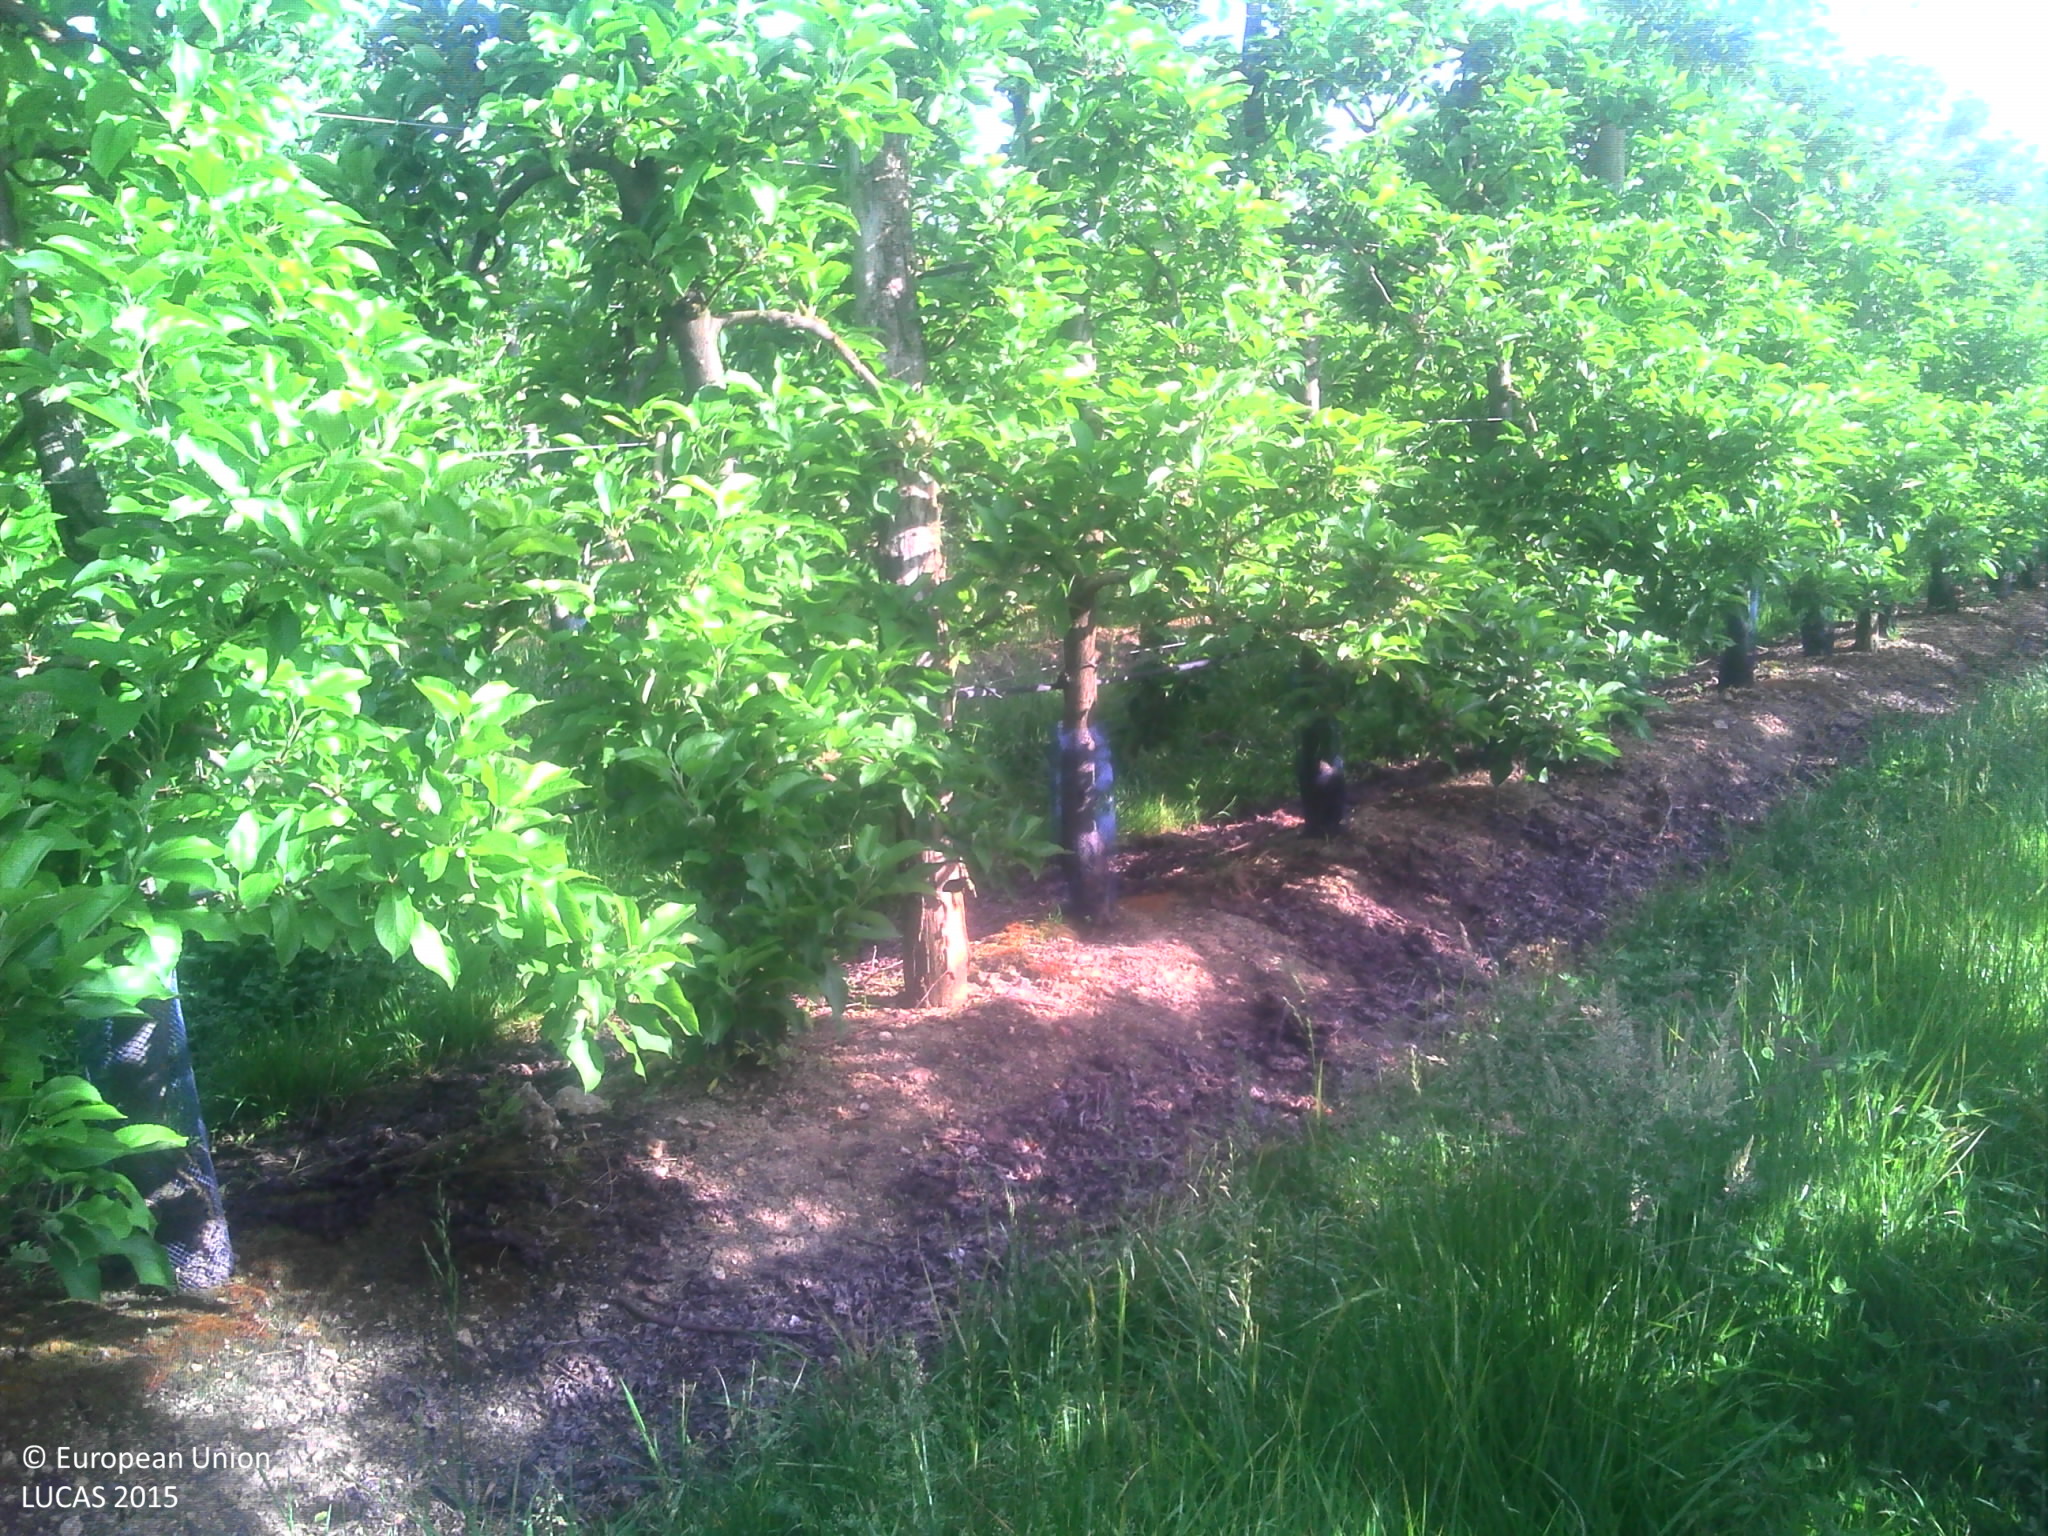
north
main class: Cropland
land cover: Apple fruit
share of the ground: 50 - 75 %
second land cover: Grassland without tree/shrub cover
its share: 50 - 75 %
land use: Agriculture (excluding fallow land and kitchen gardens)
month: May
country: FR
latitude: 47.4377
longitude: -0.9752
